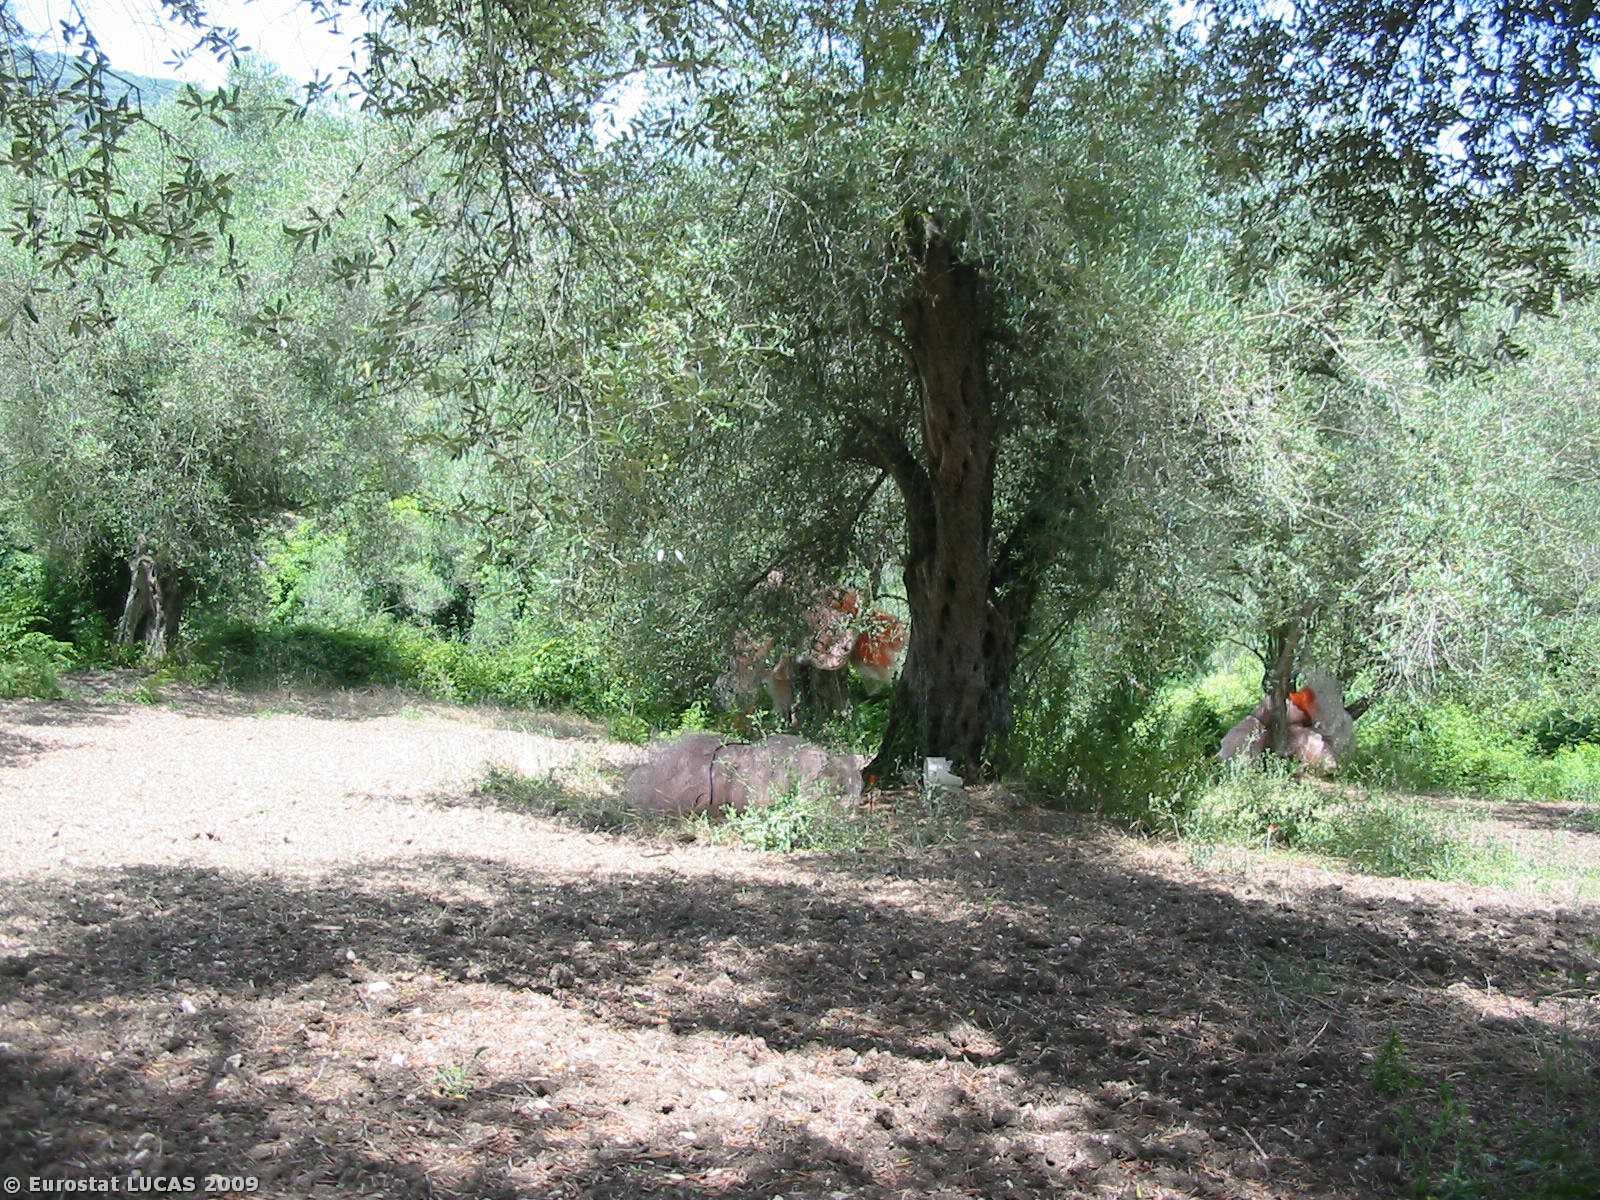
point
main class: Cropland
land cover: Olive groves
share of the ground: 50 - 75 %
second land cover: Bare land
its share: > 75 %
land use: Agriculture (excluding fallow land and kitchen gardens)
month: July
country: IT
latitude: 38.5602
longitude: 15.9676
